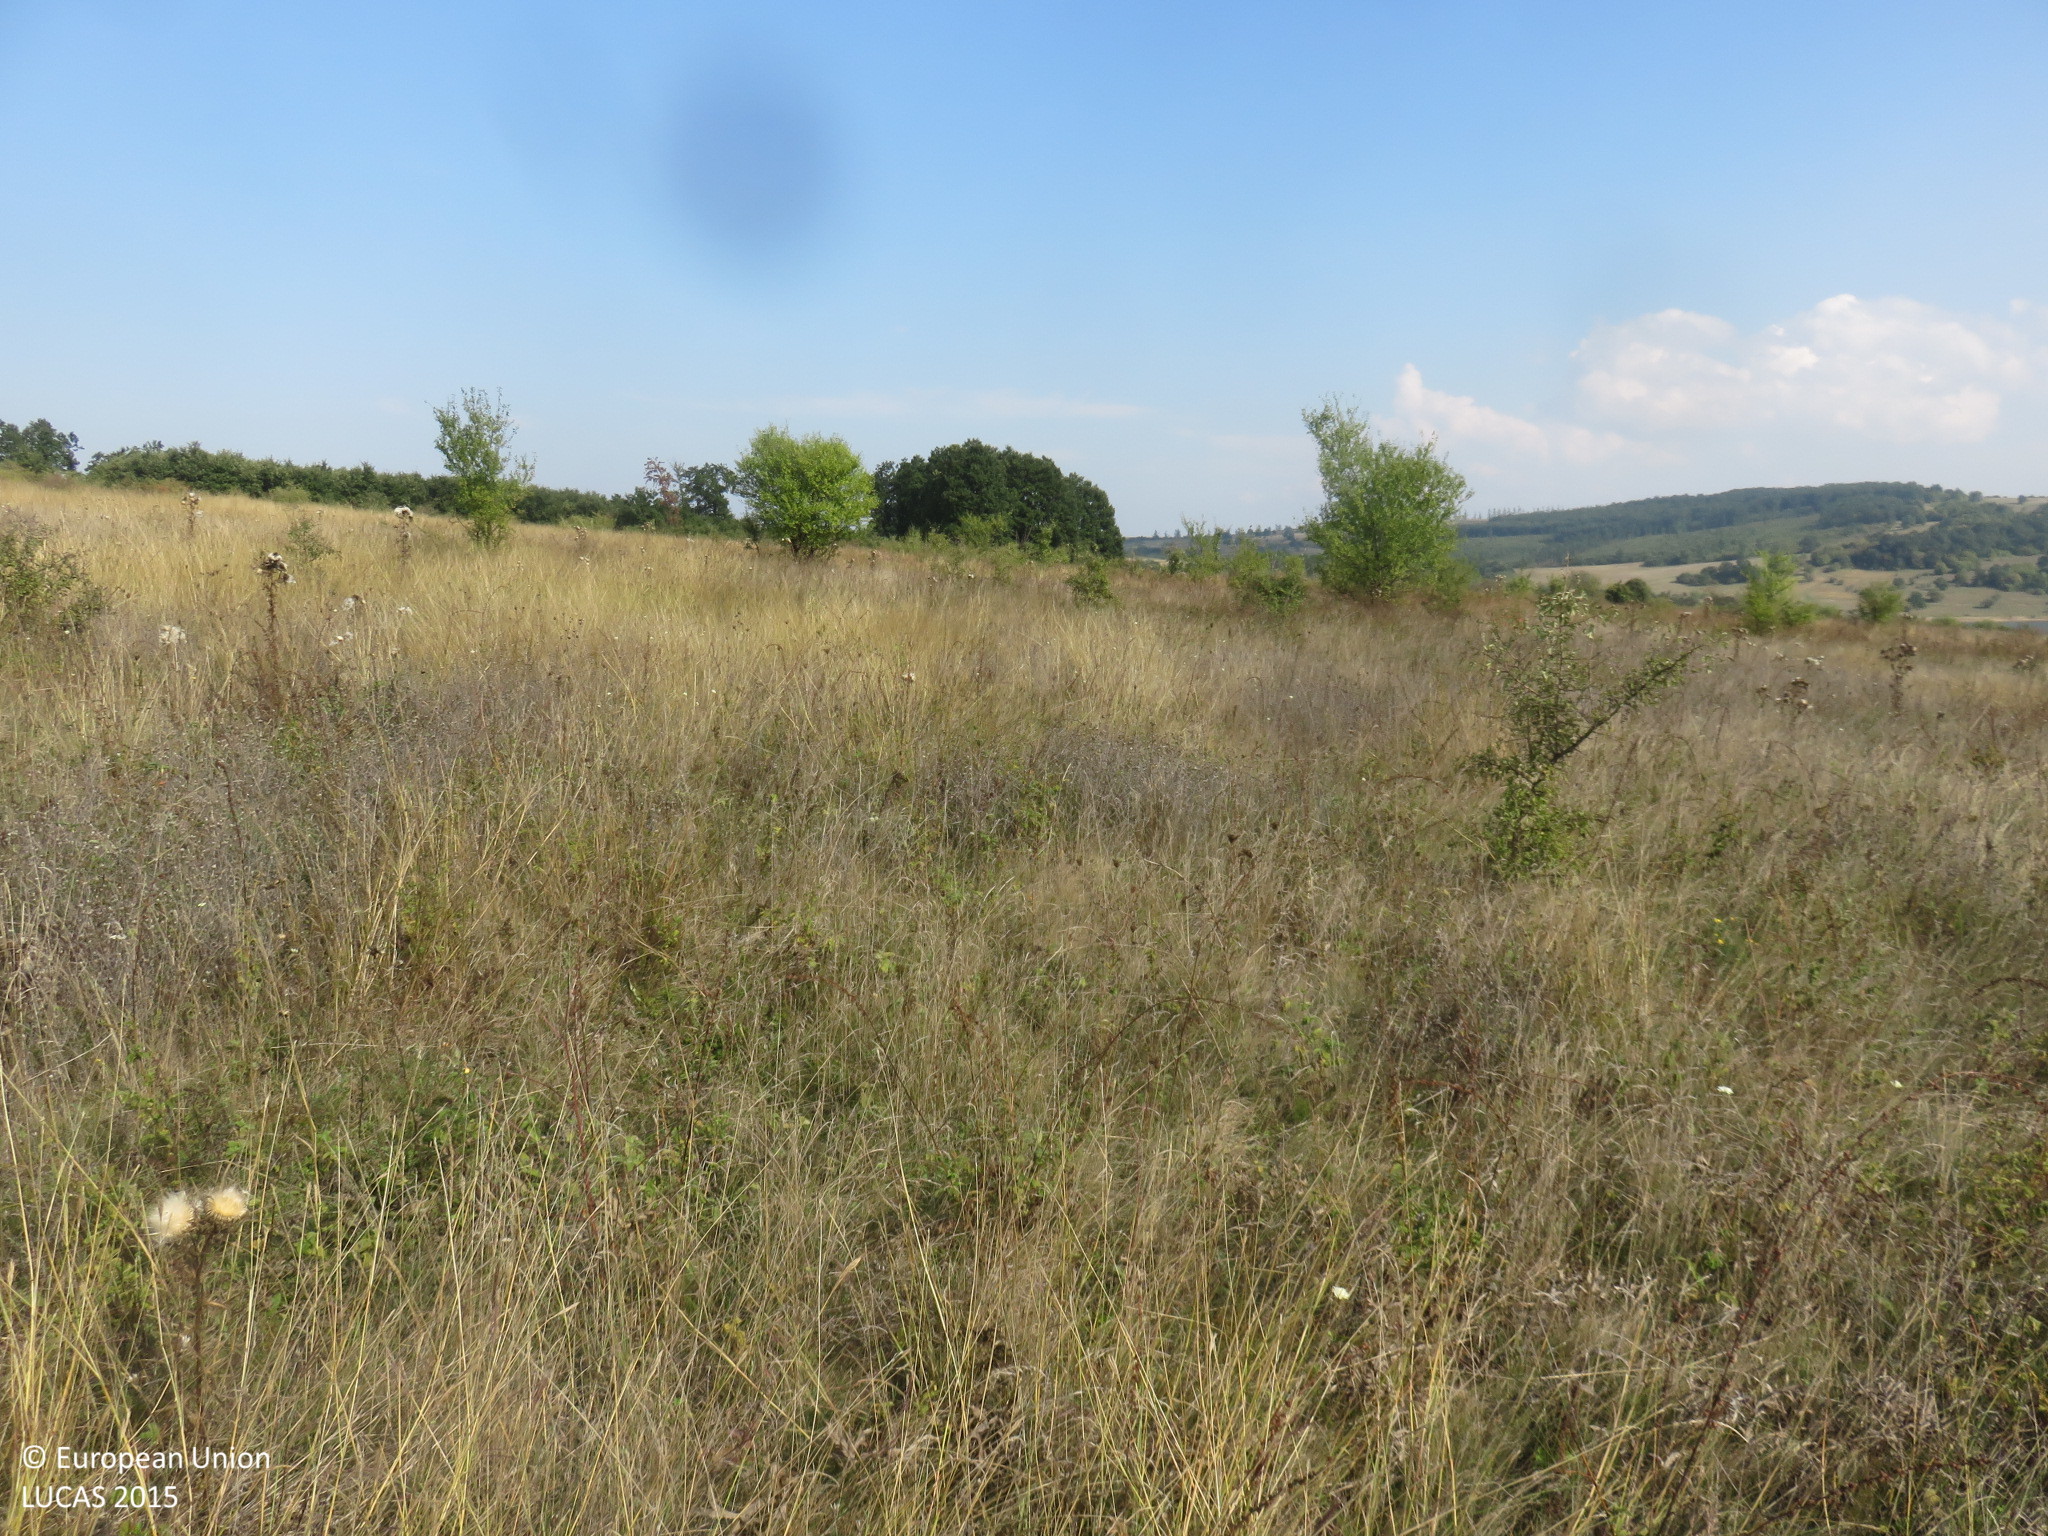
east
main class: Grassland
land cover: Grassland with sparse tree/shrub cover
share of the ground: > 75 %
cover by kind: herbaceous plants 90 %, broadleaved forest trees 5 %, shrubs 5 %
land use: Fallow land
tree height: < 5 m
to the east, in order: Grassland with sparse tree/shrub cover; Tracks; Grassland with sparse tree/shrub cover; Tracks; Grassland with sparse tree/shrub cover; Broadleaved woodland
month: September
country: BG
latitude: 43.1561
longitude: 25.0348
